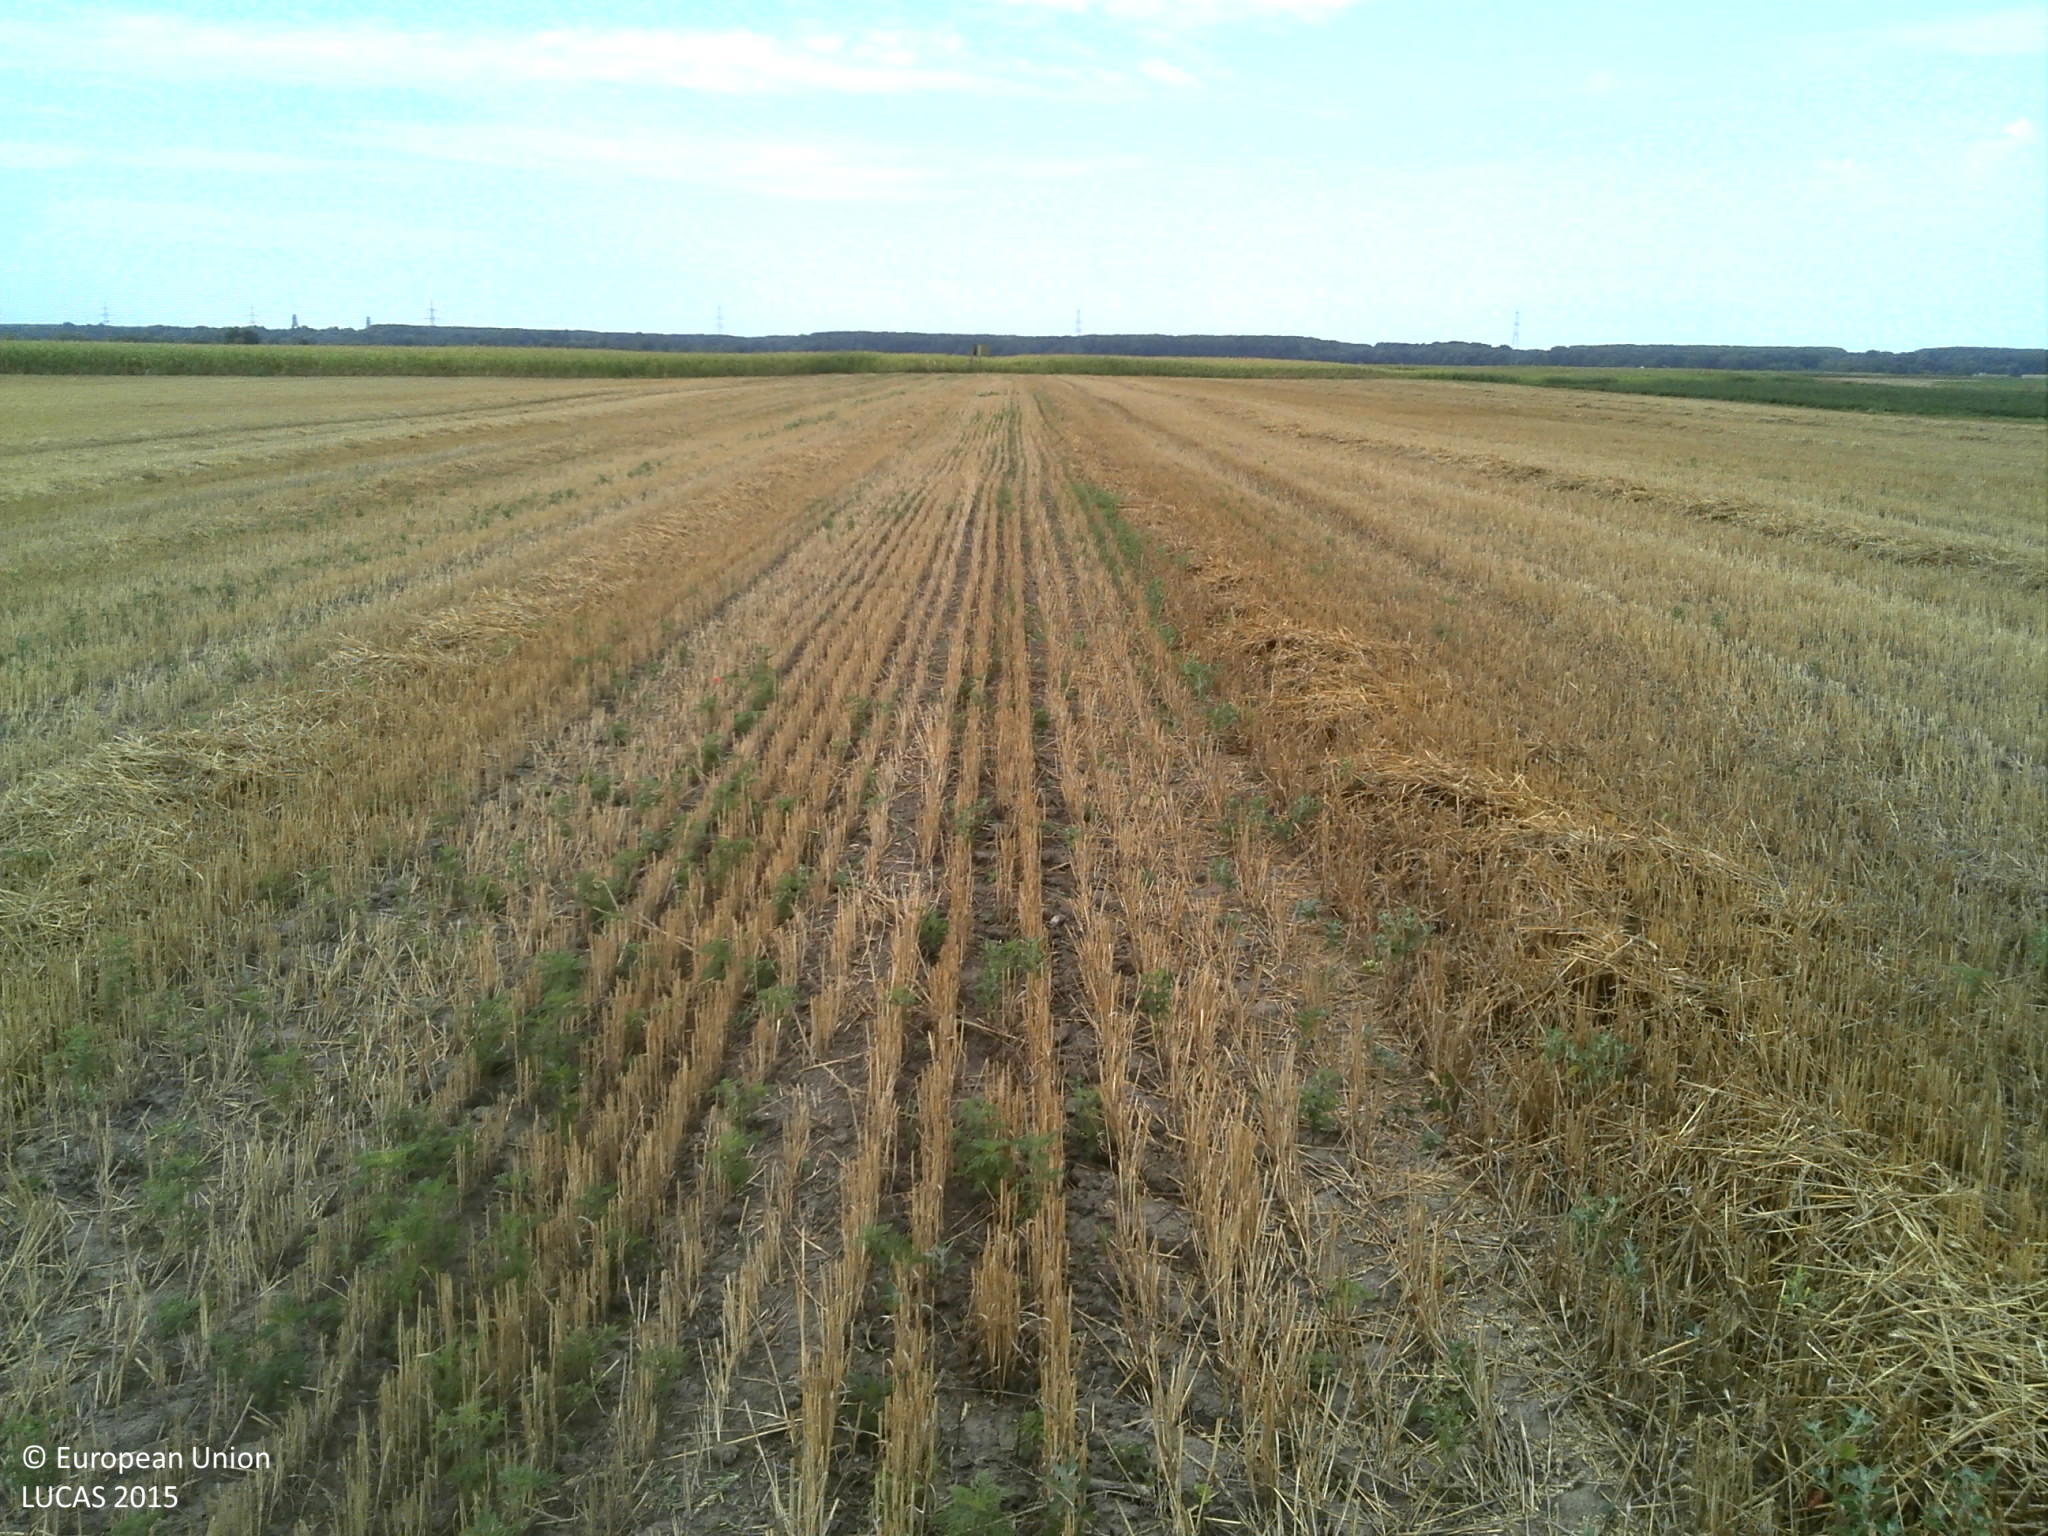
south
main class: Cropland
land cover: Common wheat
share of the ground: > 75 %
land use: Agriculture (excluding fallow land and kitchen gardens)
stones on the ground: < 10 %
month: July
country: HR
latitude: 45.6607
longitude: 18.5937
